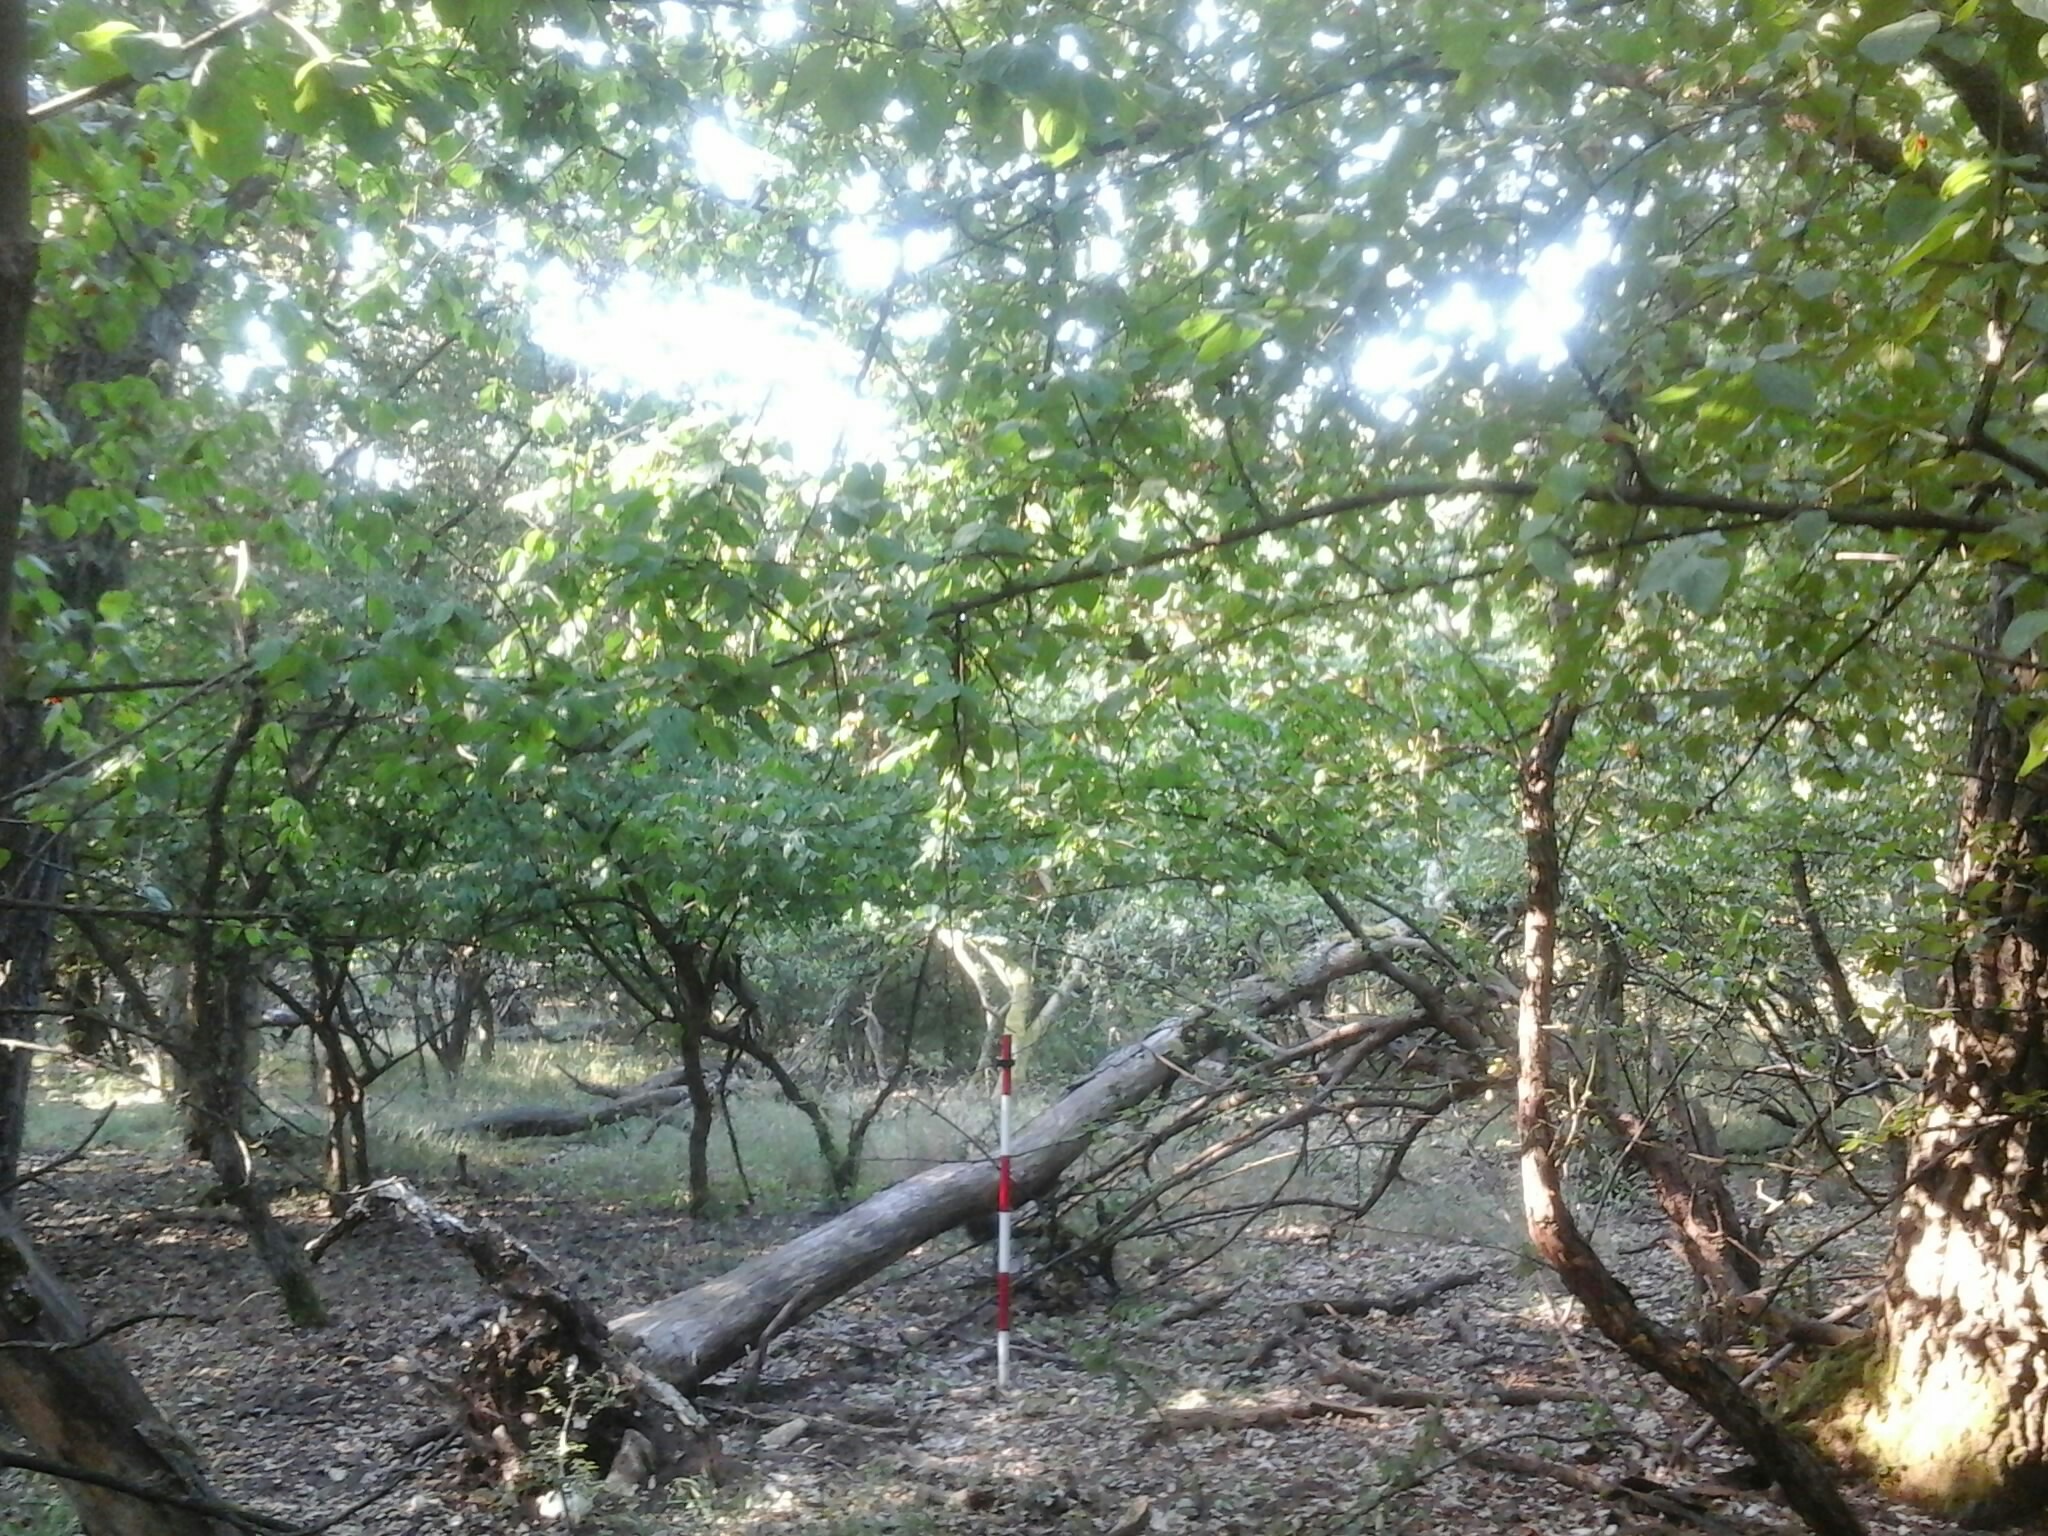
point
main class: Woodland
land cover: Broadleaved woodland
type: mesophytic deciduous forest
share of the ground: > 75 %
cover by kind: broadleaved forest trees 85 %, herbaceous plants 10 %, unconsolidated bare surface 5 %
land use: Forestry
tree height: > 5 m
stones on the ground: < 10 %
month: August
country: HU
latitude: 47.3822
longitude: 18.3440
